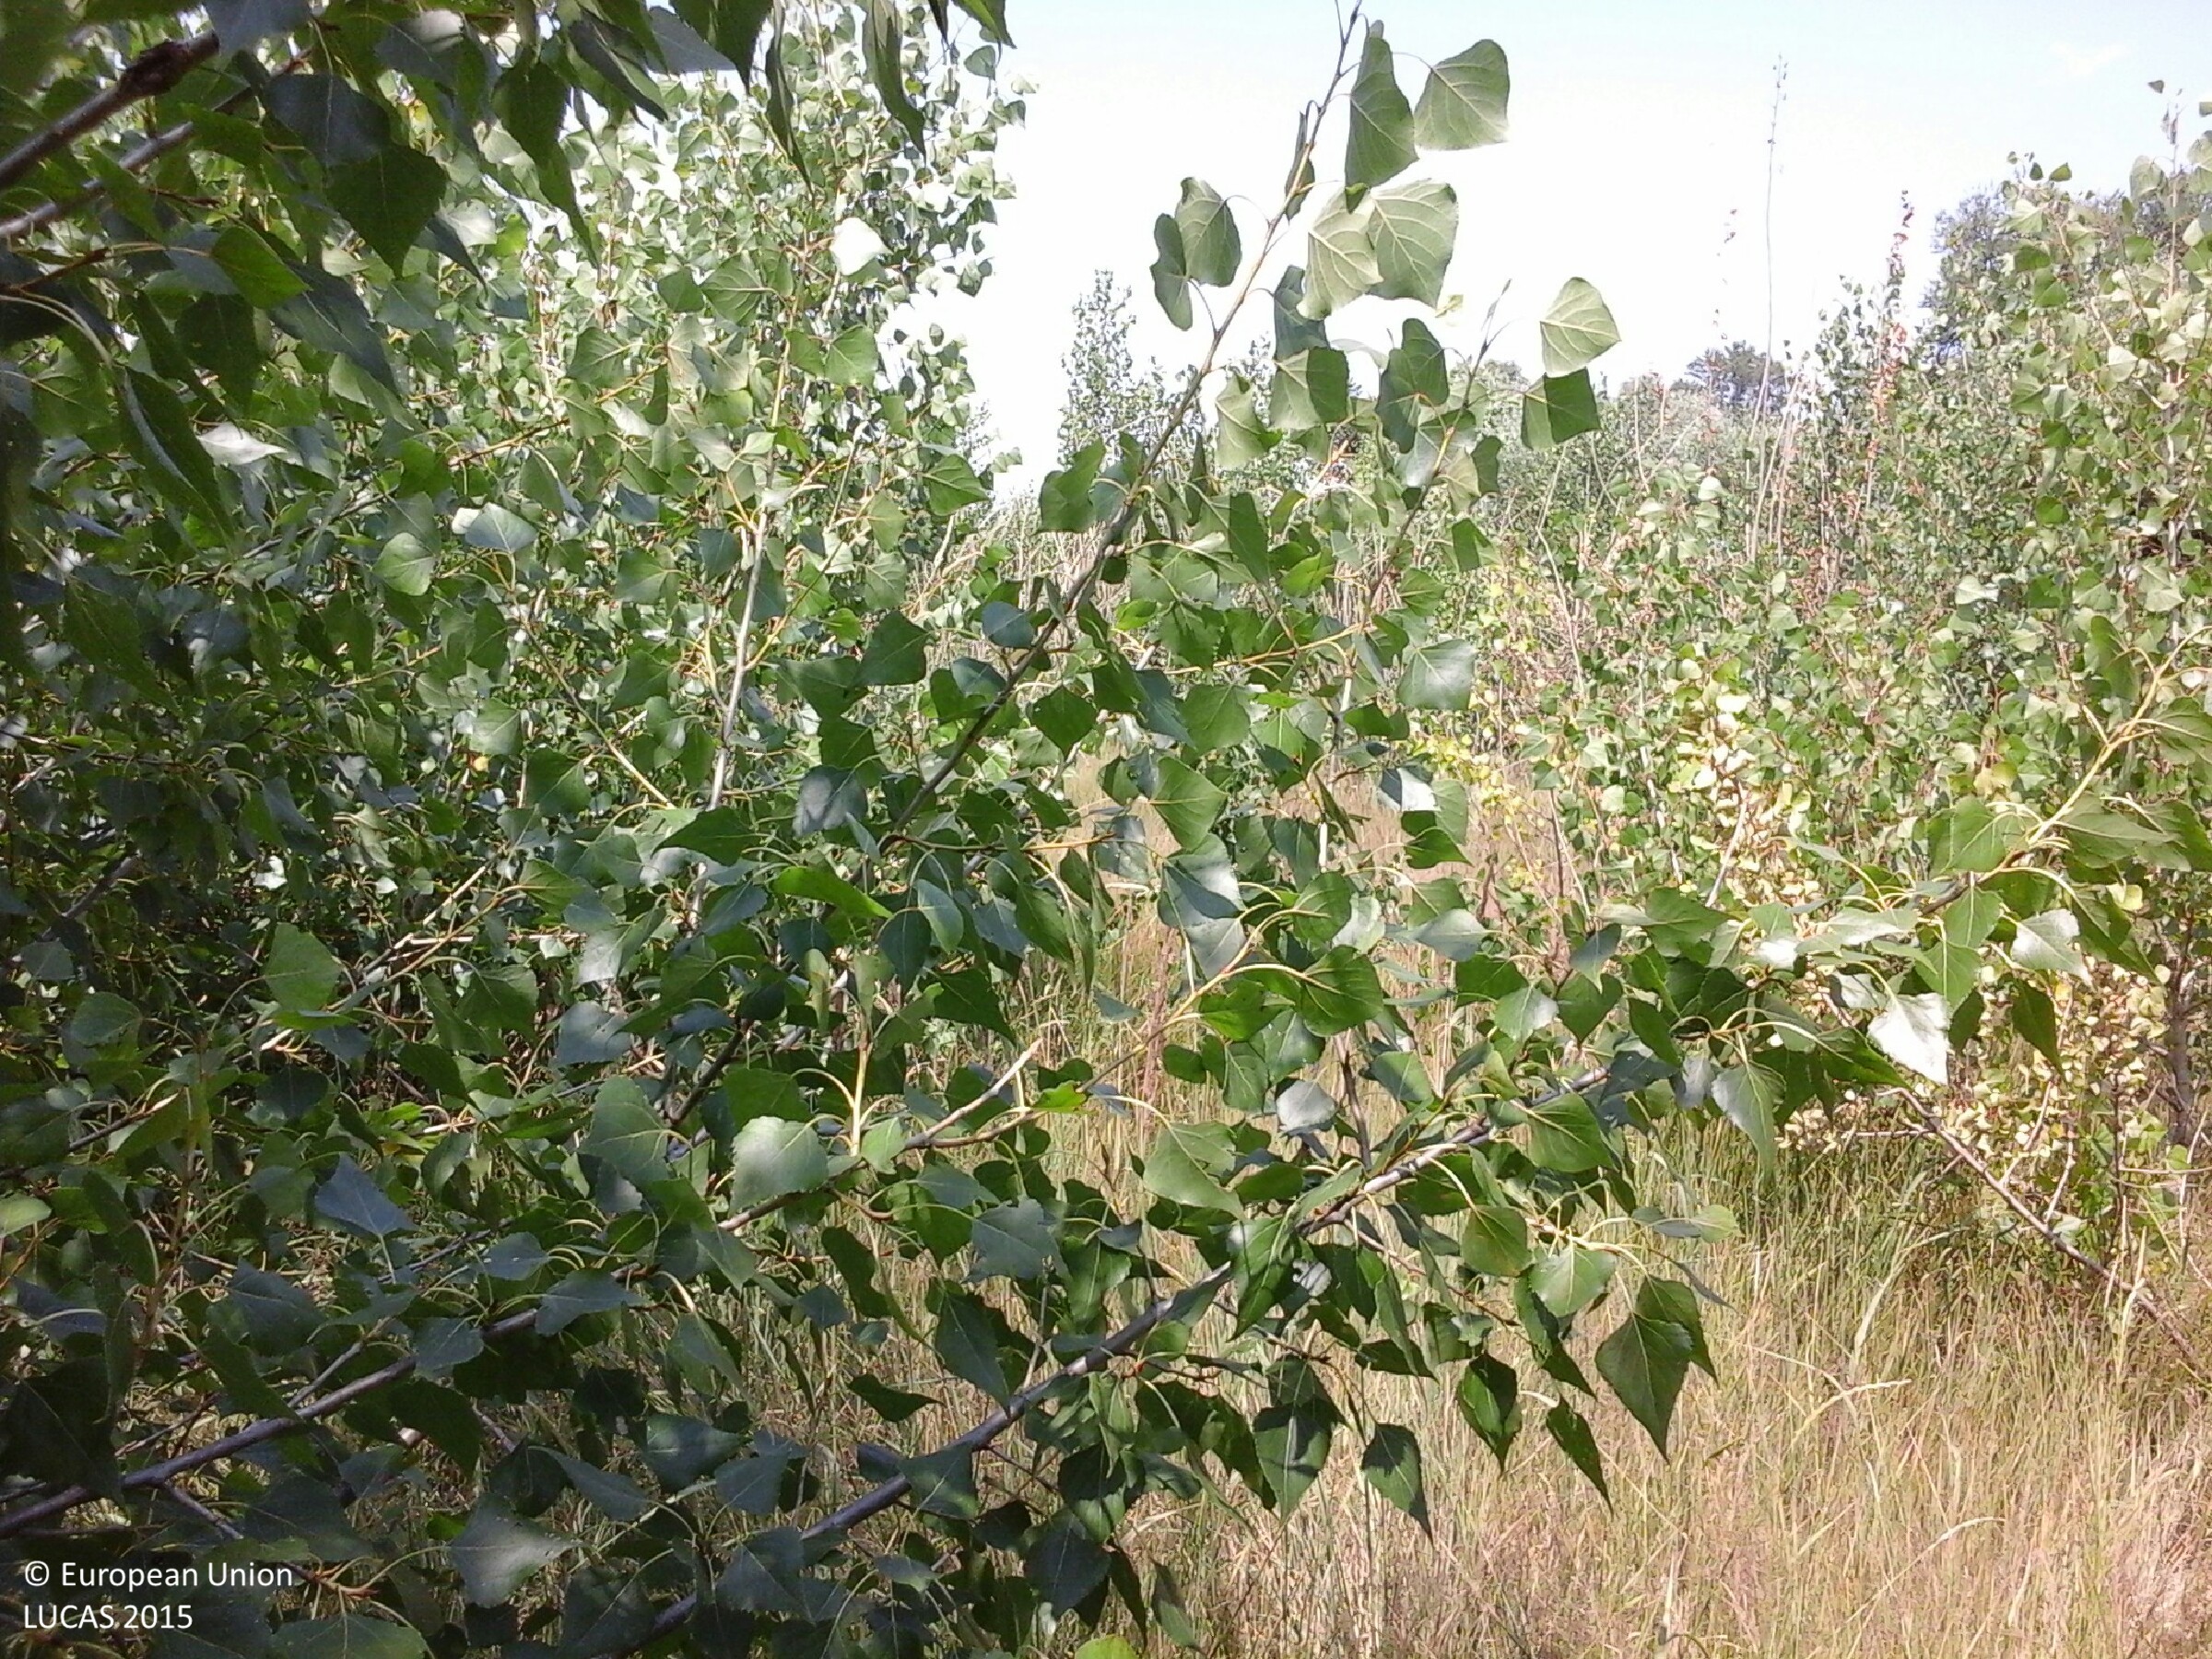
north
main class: Woodland
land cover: Broadleaved woodland
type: floodplain forest
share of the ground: 50 - 75 %
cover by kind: broadleaved forest trees 60 %, herbaceous plants 40 %
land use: Semi-natural and natural areas not in use
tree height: < 5 m
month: July
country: HU
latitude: 48.0455
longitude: 20.8899
